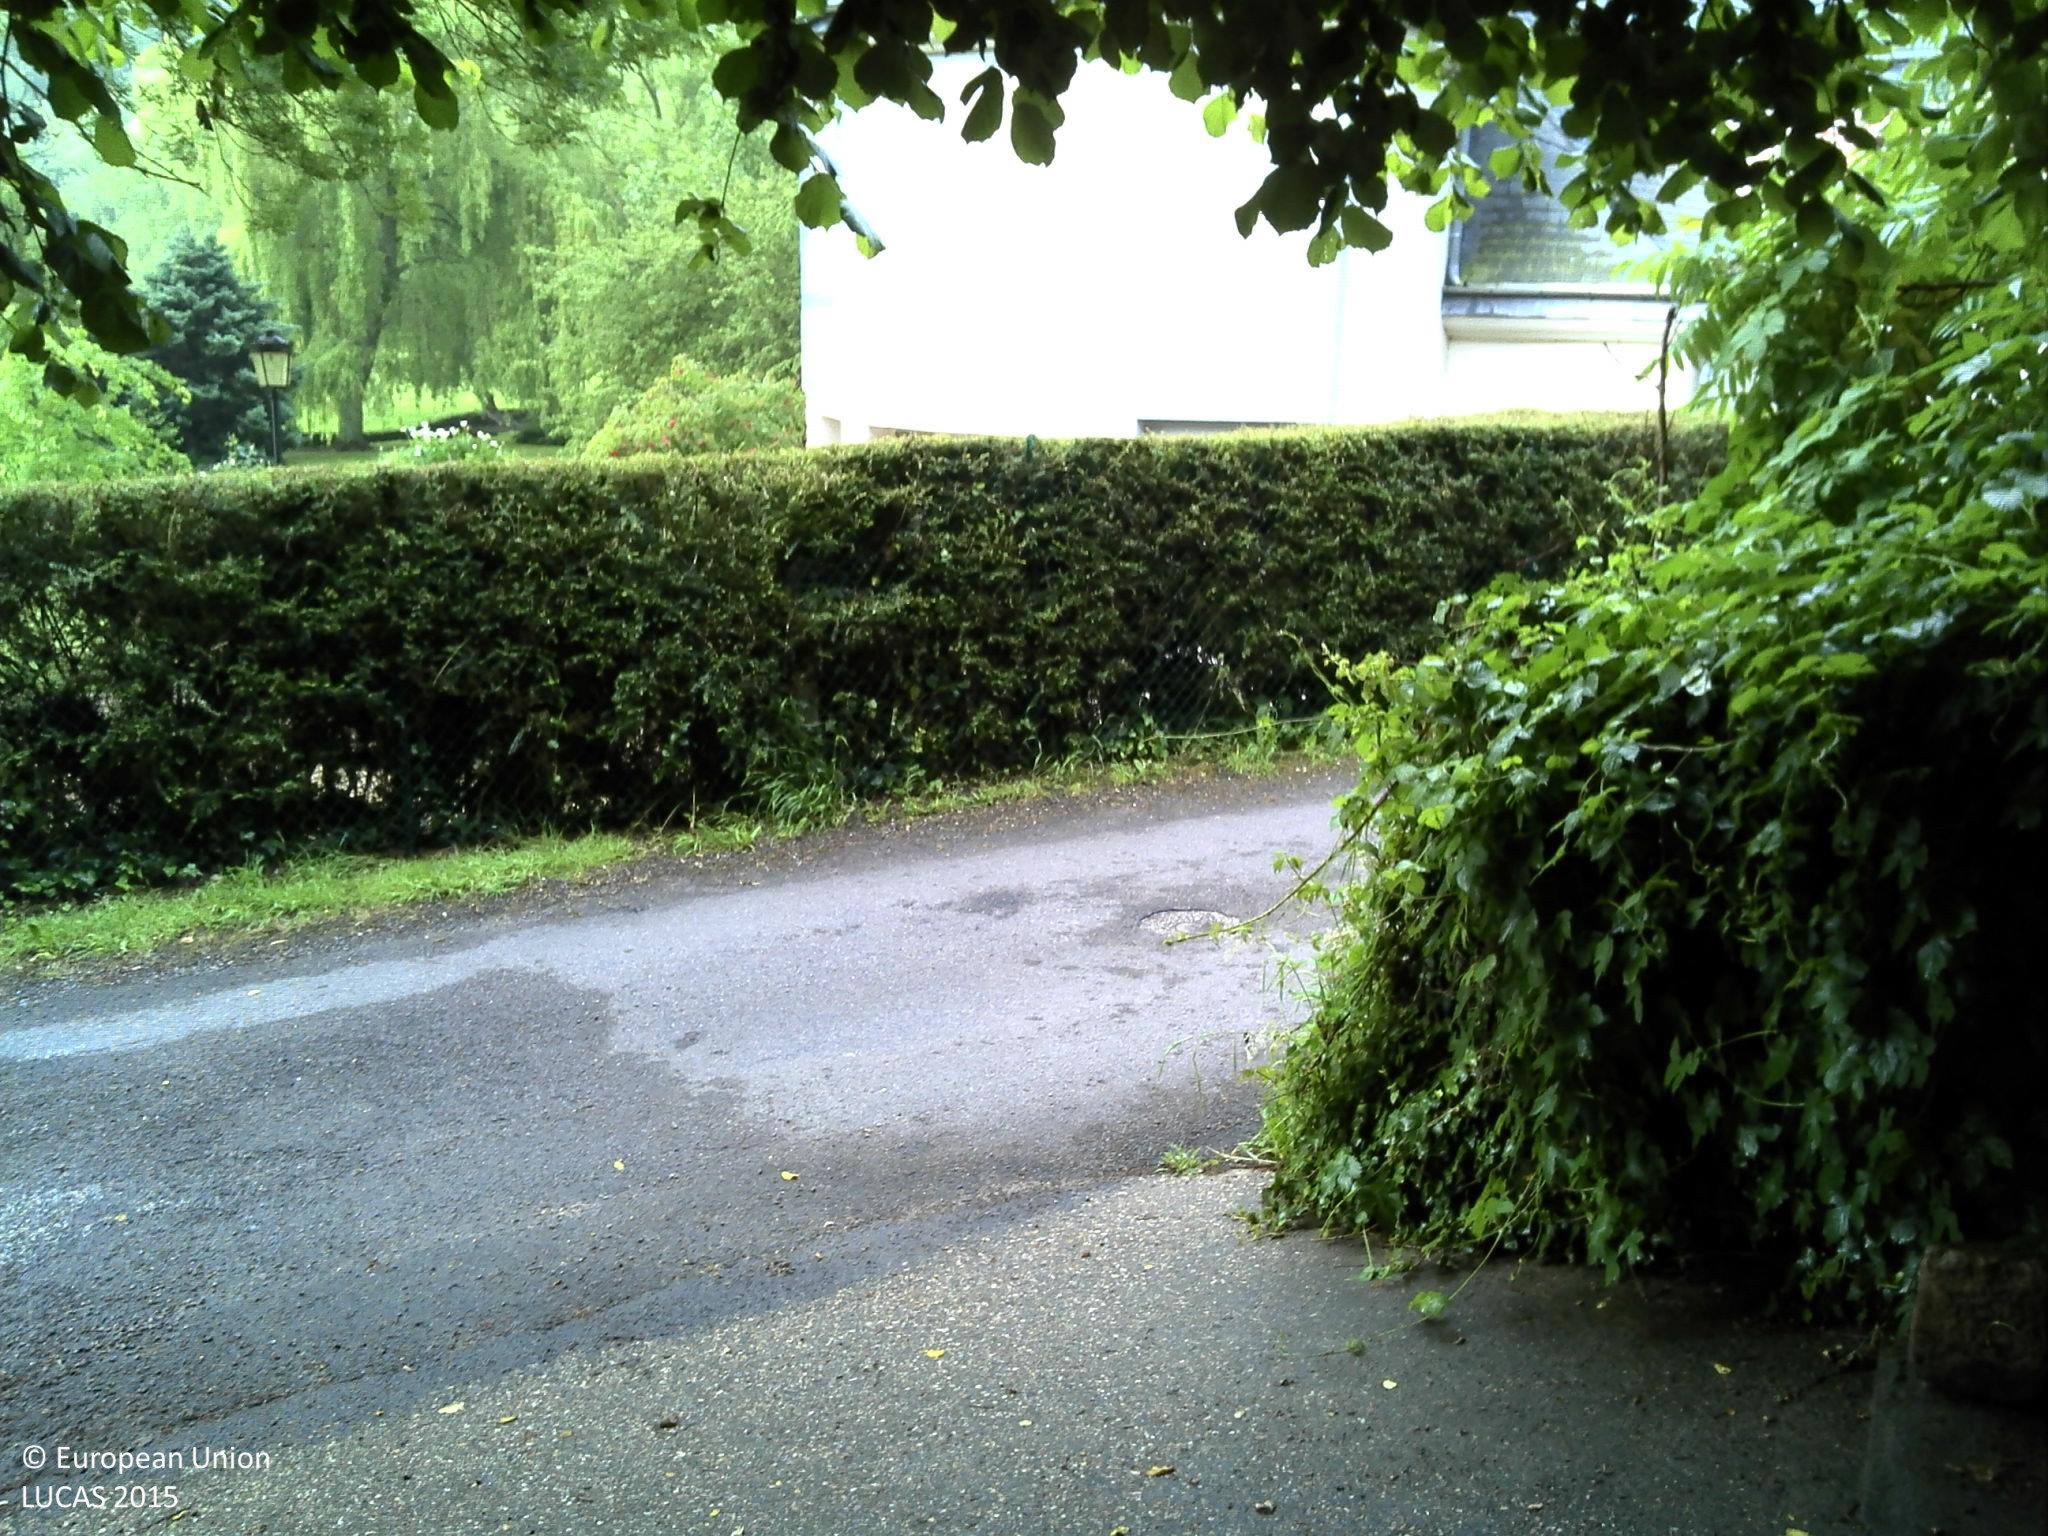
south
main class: Woodland
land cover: Broadleaved woodland
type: mesophytic deciduous forest
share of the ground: > 75 %
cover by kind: broadleaved forest trees 95 %, herbaceous plants 5 %
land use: Residential
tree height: > 5 m
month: June
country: FR
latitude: 49.4974
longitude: 0.2925
